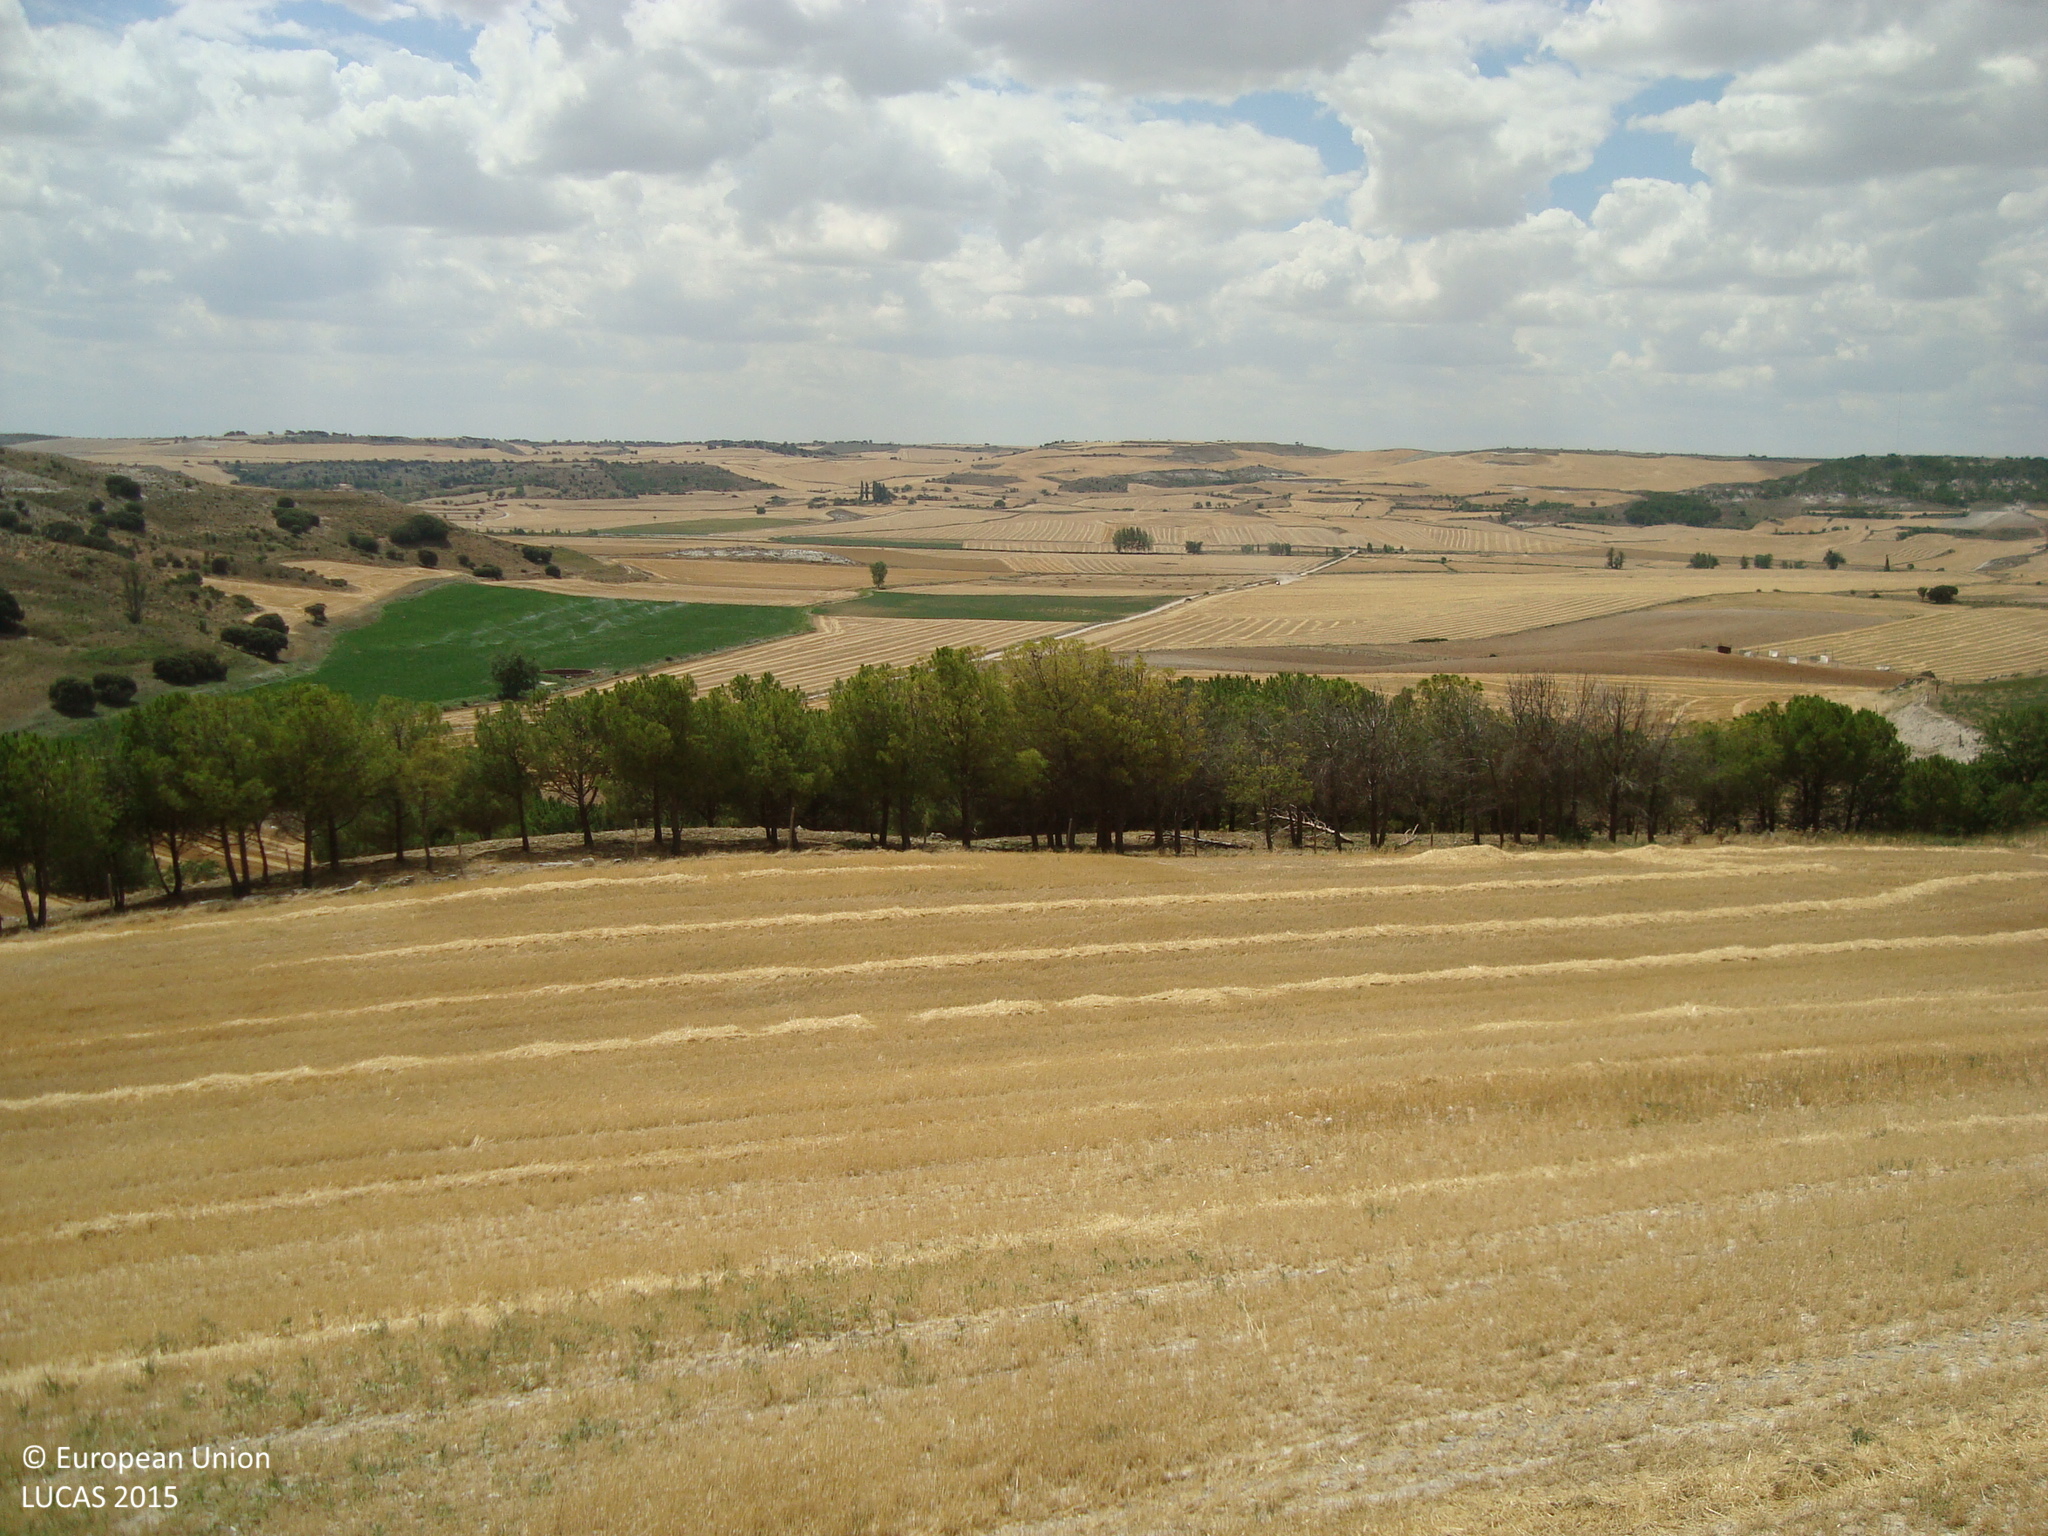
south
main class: Cropland
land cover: Barley
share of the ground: > 75 %
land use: Agriculture (excluding fallow land and kitchen gardens)
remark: Harvested field
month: July
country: ES
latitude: 41.9568
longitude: -4.2161
